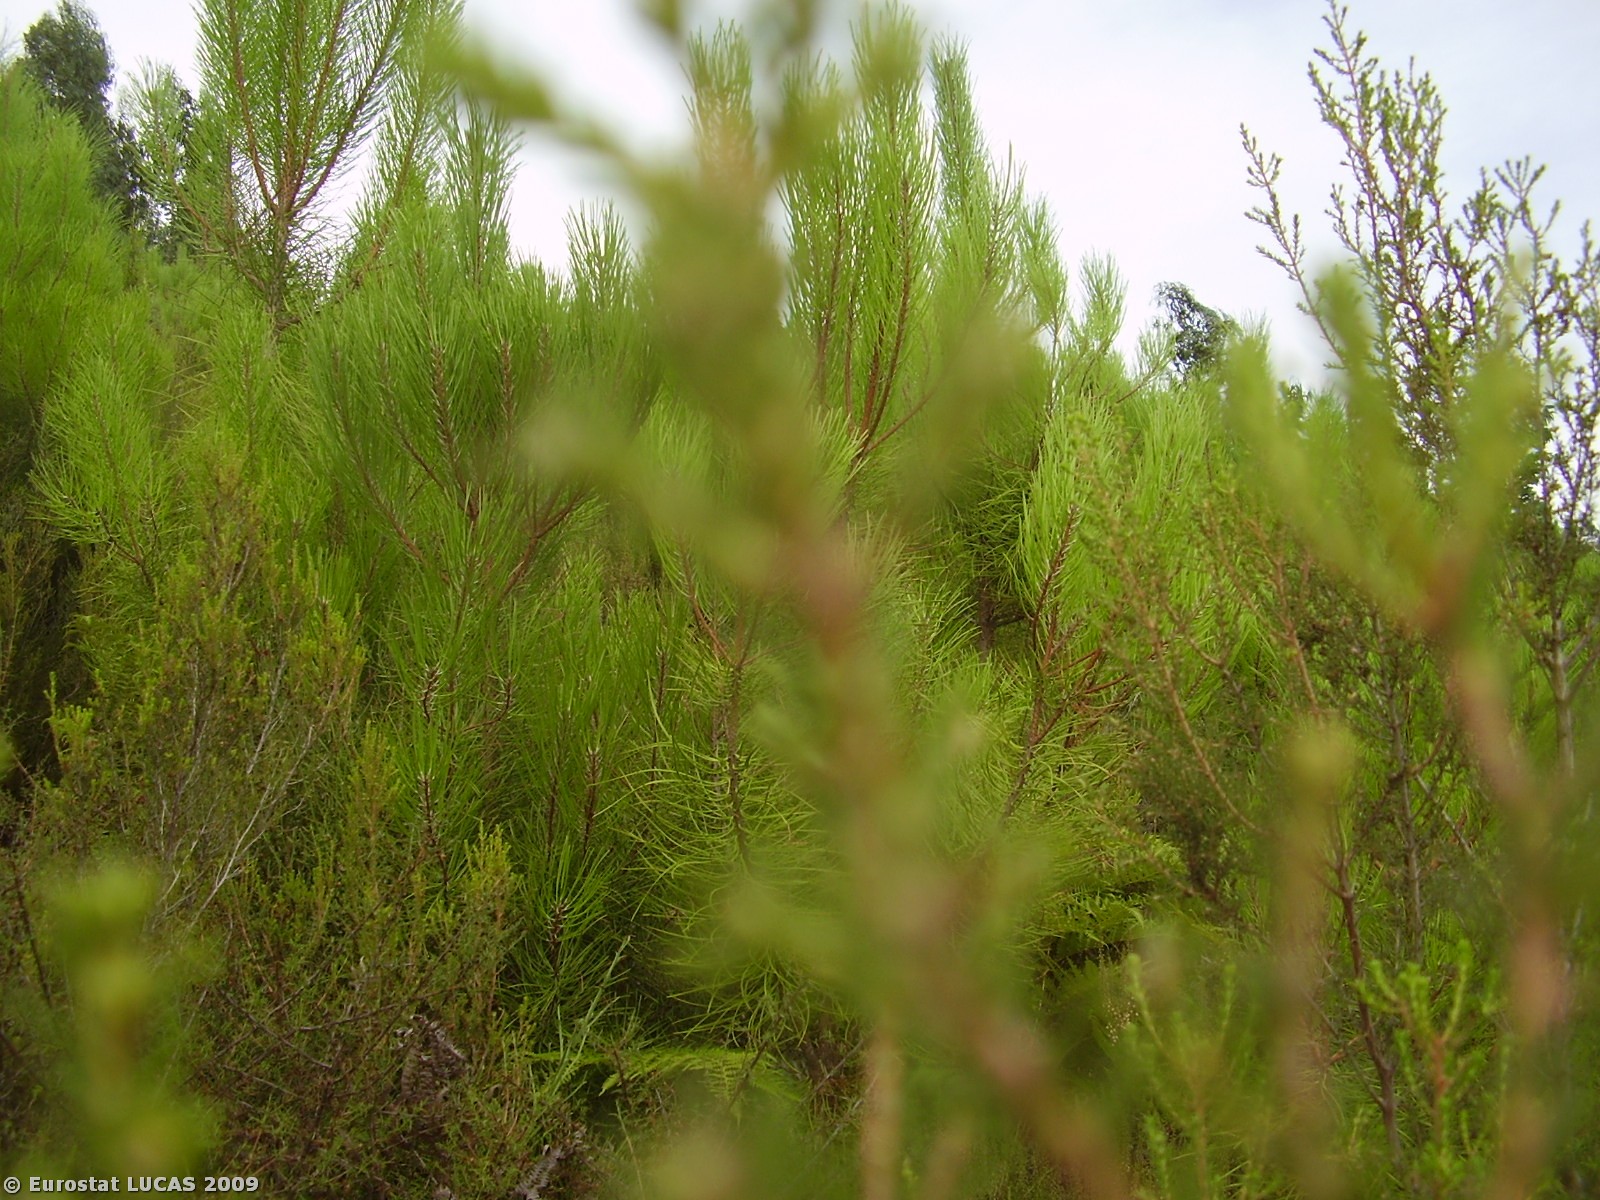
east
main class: Woodland
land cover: Coniferous woodland
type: coniferous forest of the mediterranean region
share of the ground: 50 - 75 %
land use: Forestry
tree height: > 5 m
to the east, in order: Coniferous woodland; Broadleaved woodland; Tracks; Broadleaved woodland; Tracks; Broadleaved woodland; Rivers and streams; Shrubland without tree cover; Broadleaved woodland
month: July
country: PT
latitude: 39.5197
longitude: -8.2473
